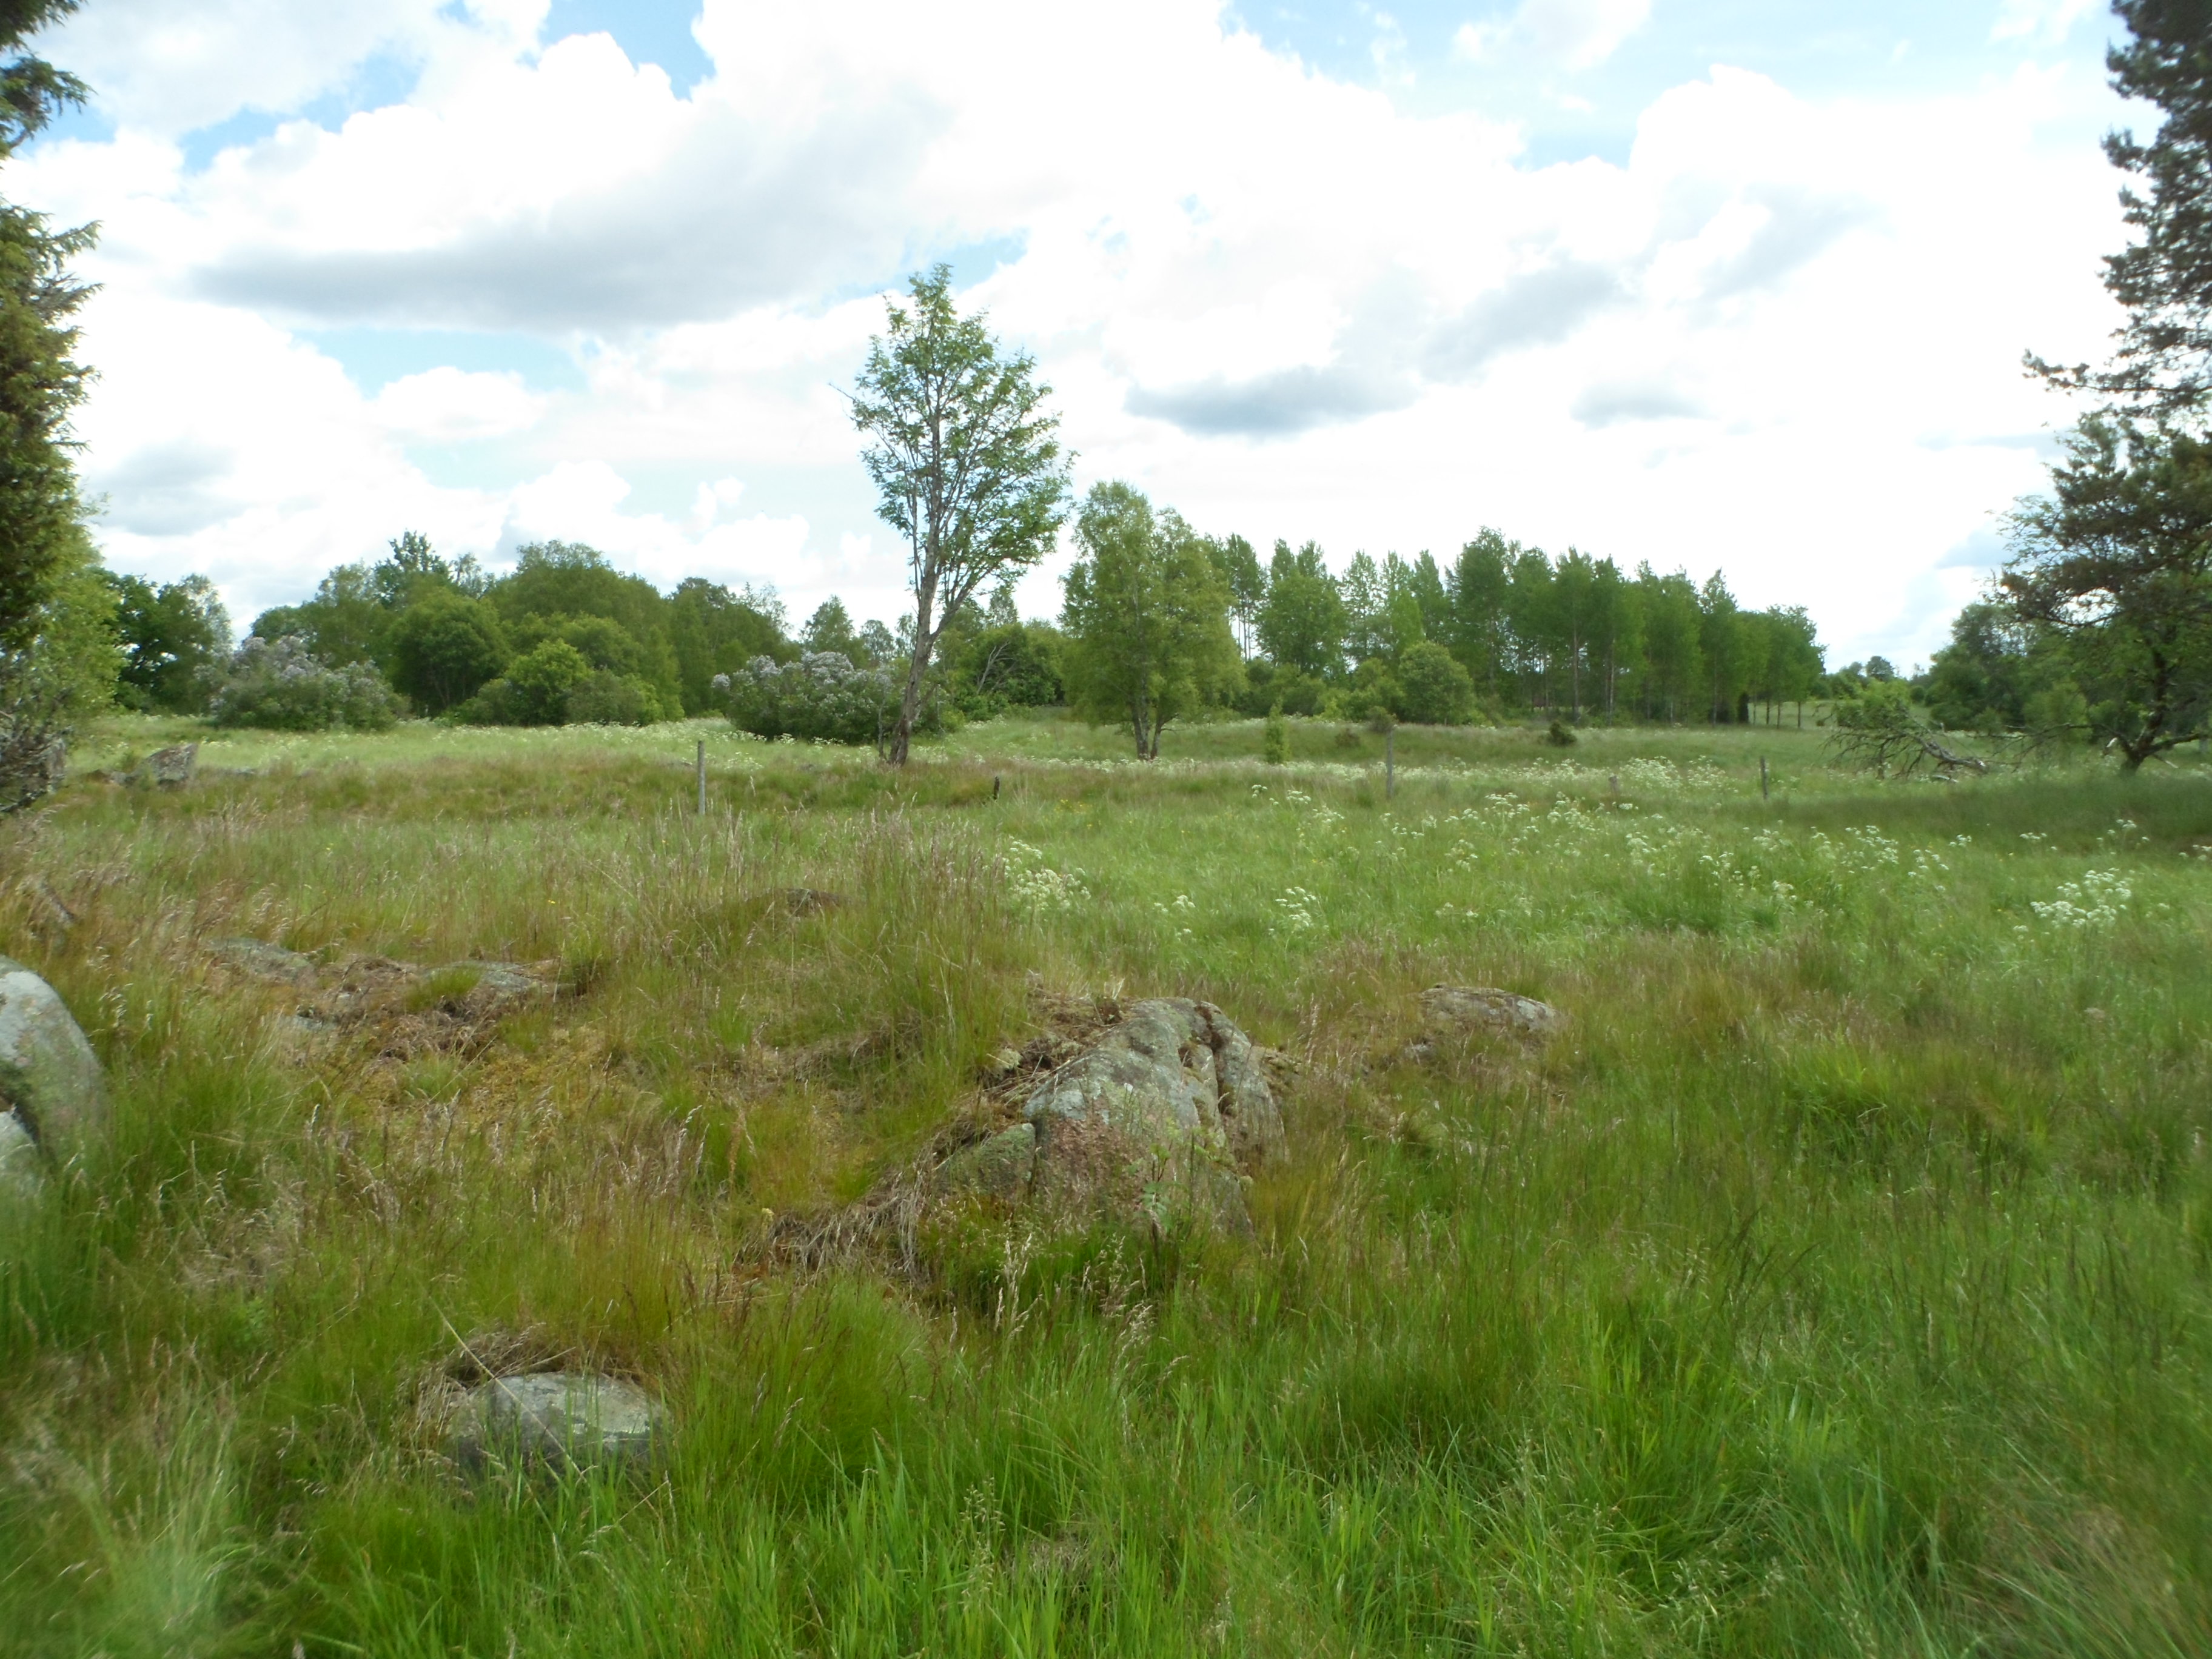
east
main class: Grassland
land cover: Grassland with sparse tree/shrub cover
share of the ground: > 75 %
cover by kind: herbaceous plants 90 %, broadleaved forest trees 5 %, shrubs 5 %
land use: Agriculture (excluding fallow land and kitchen gardens)
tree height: < 5 m
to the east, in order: Grassland with sparse tree/shrub cover; Fences; Grassland with sparse tree/shrub cover; Grassland without tree/shrub cover; Broadleaved woodland; Grassland with sparse tree/shrub cover; Broadleaved woodland; Ditches and canals; Broadleaved woodland; Paved roads, cycling and walking lanes; Ditches and canals; Grassland without tree/shrub cover; Oats
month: June
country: SE
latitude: 57.3086
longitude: 14.1626
